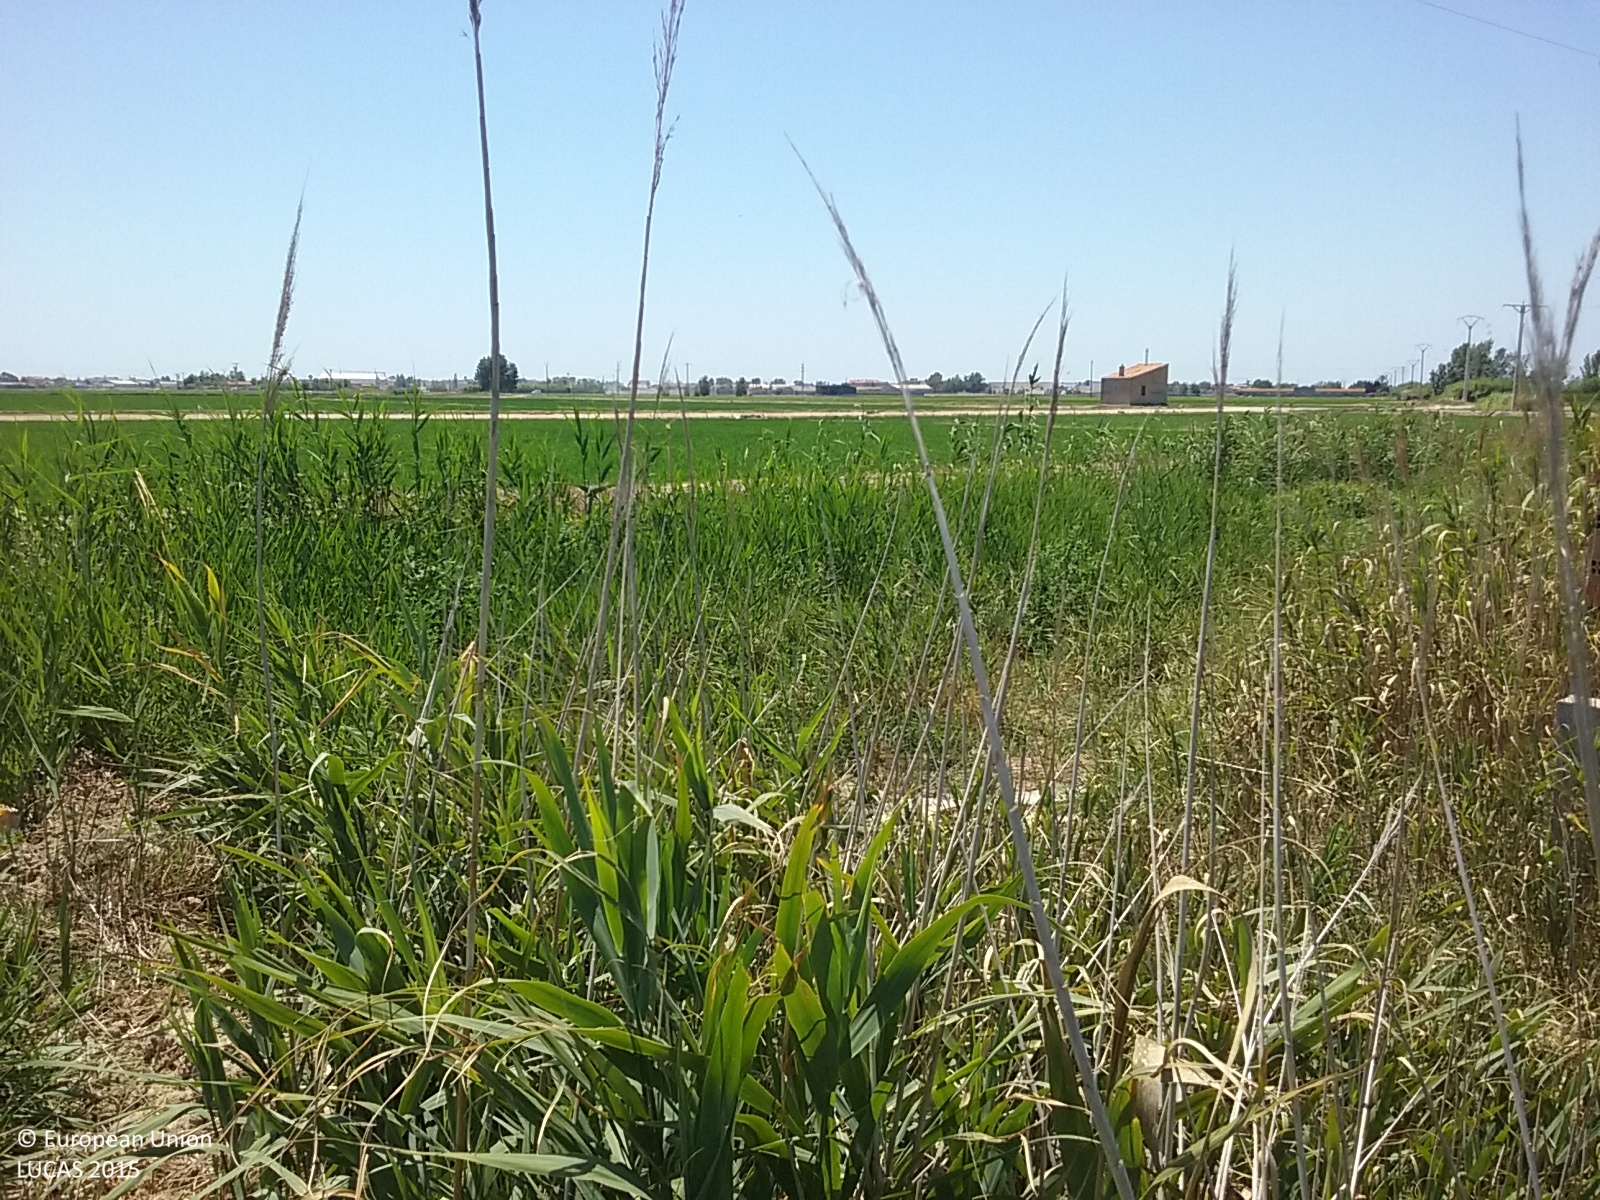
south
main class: Cropland
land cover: Rice
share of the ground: 25 - 50 %
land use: Agriculture (excluding fallow land and kitchen gardens)
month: June
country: ES
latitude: 40.7368
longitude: 0.7234
